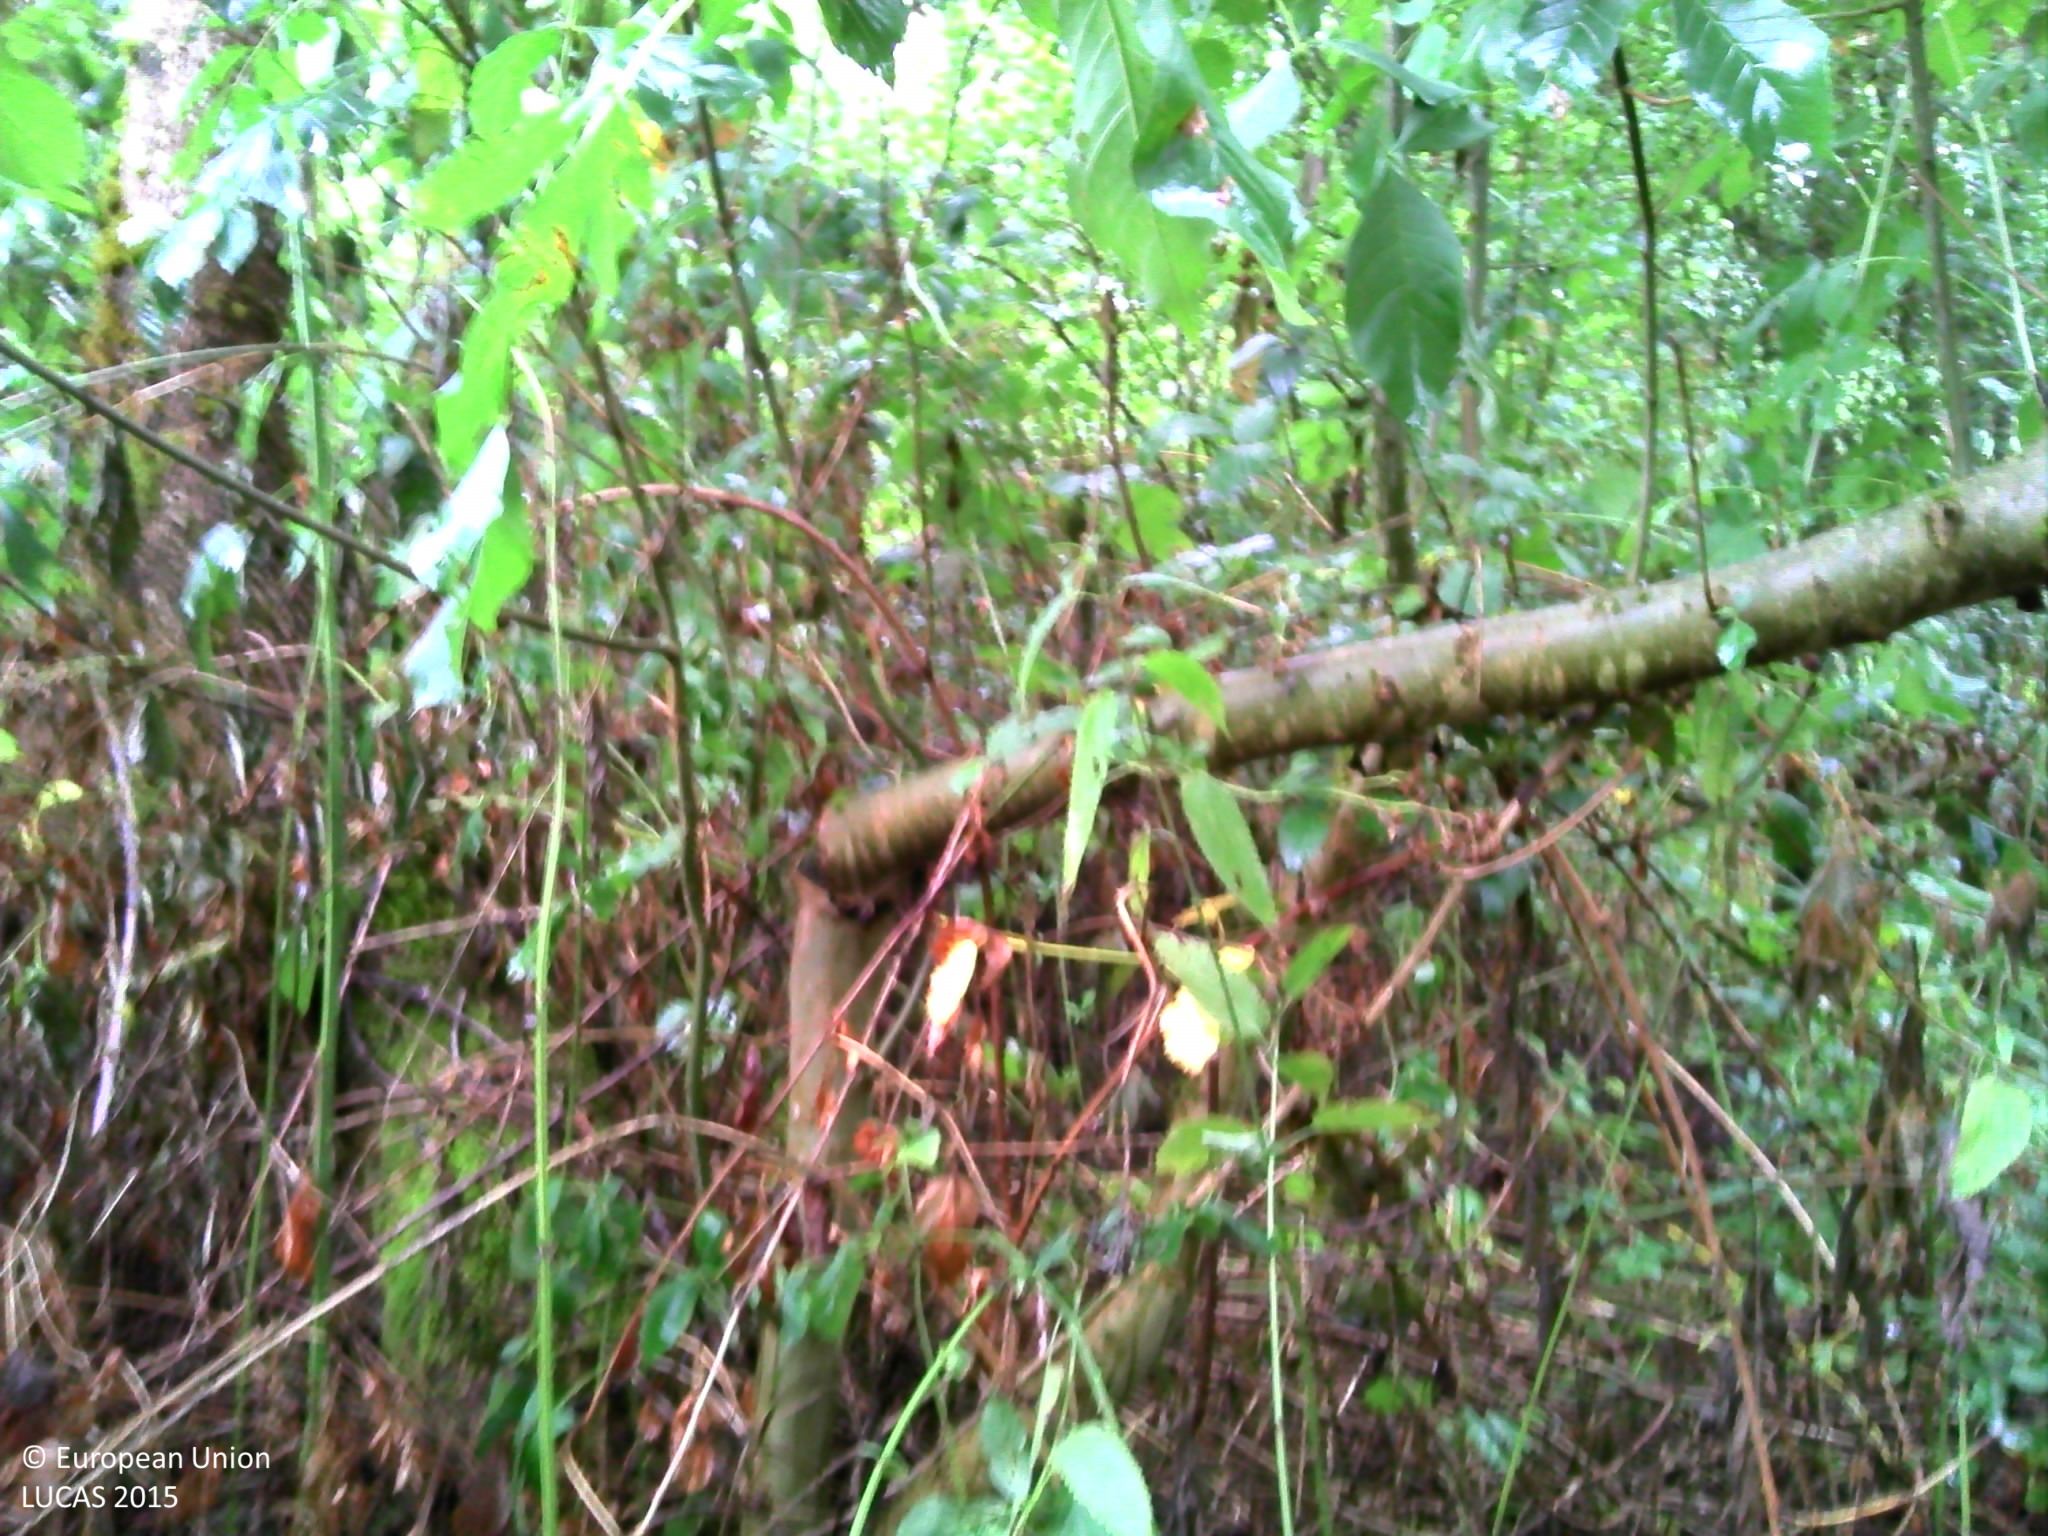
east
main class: Woodland
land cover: Broadleaved woodland
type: mesophytic deciduous forest
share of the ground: > 75 %
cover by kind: broadleaved forest trees 80 %, herbaceous plants 15 %, lichens and mosses 5 %
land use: Semi-natural and natural areas not in use
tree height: > 5 m
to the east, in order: Broadleaved woodland; Fences; Grassland without tree/shrub cover; Fences; Lines of trees; Grass margins; Spontaneously vegetated surfaces
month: August
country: FR
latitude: 47.6451
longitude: 3.0854
